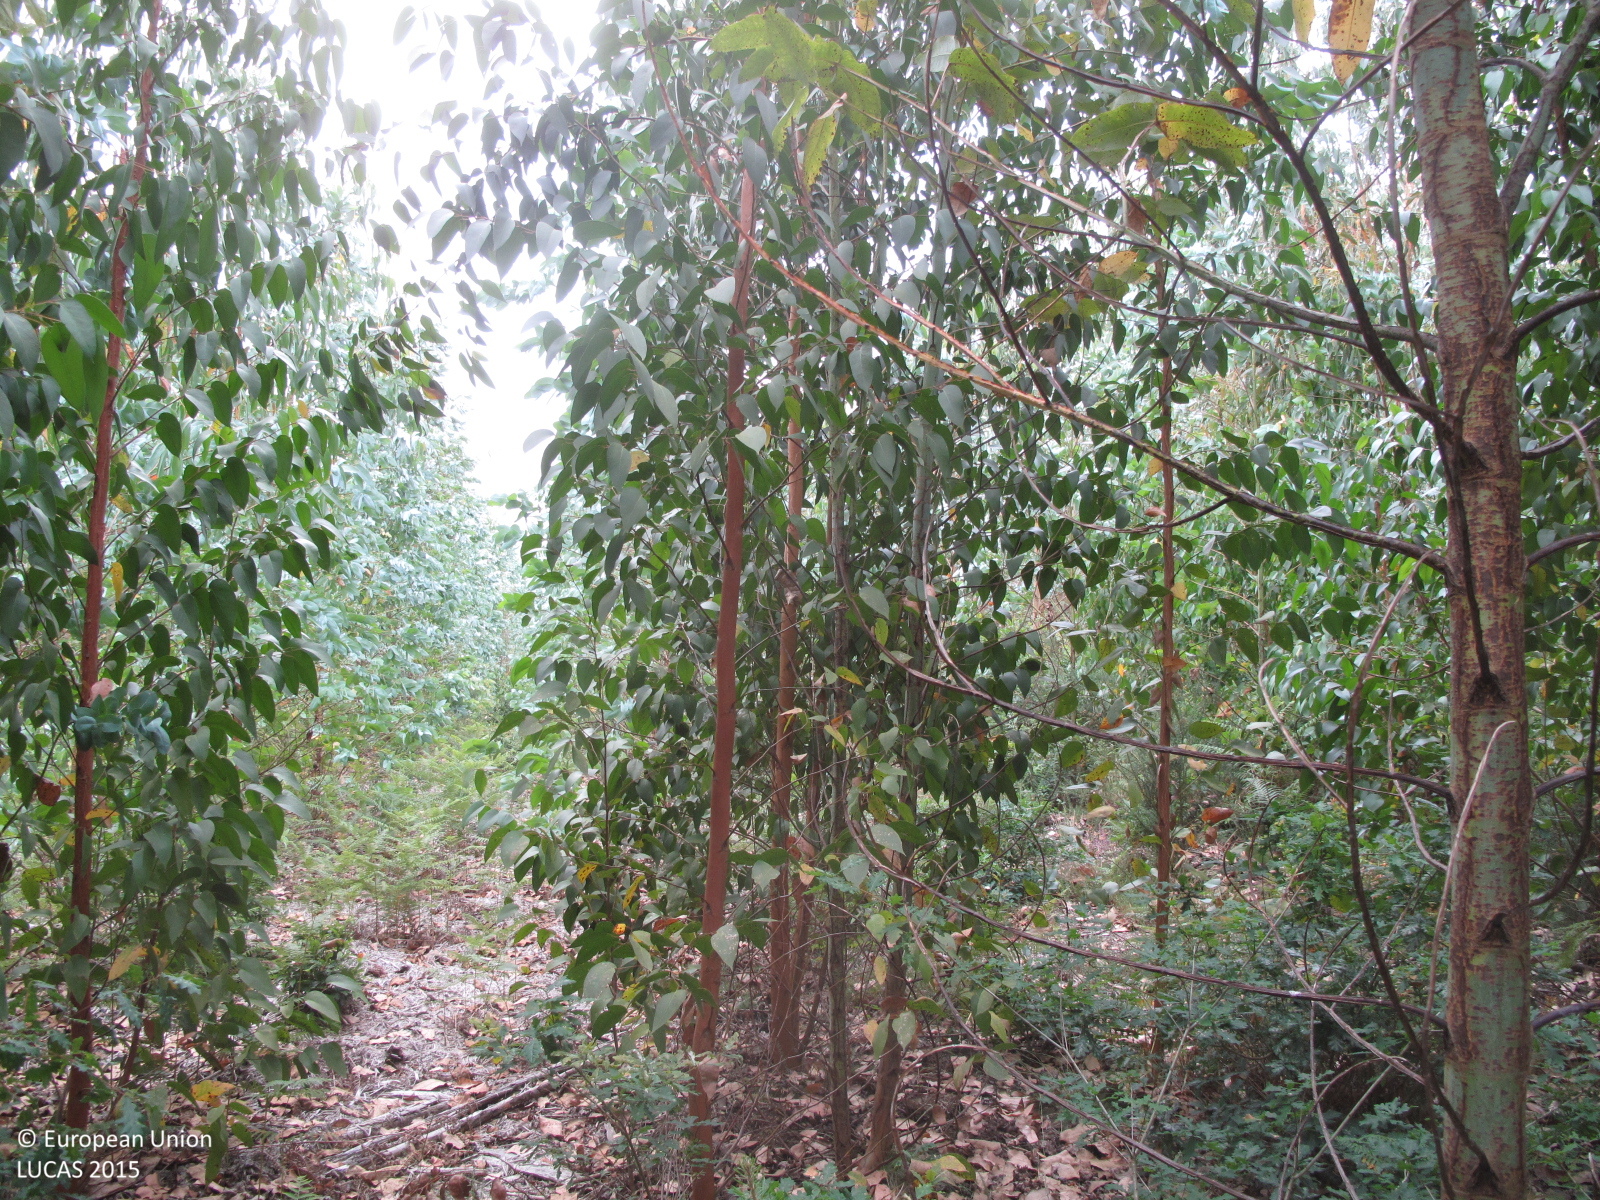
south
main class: Woodland
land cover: Broadleaved woodland
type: exotic forest
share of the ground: 50 - 75 %
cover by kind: broadleaved forest trees 60 %, herbaceous plants 20 %, shrubs 10 %, unconsolidated bare surface 10 %
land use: Forestry
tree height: > 5 m
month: July
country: ES
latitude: 43.2645
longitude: -8.0697
